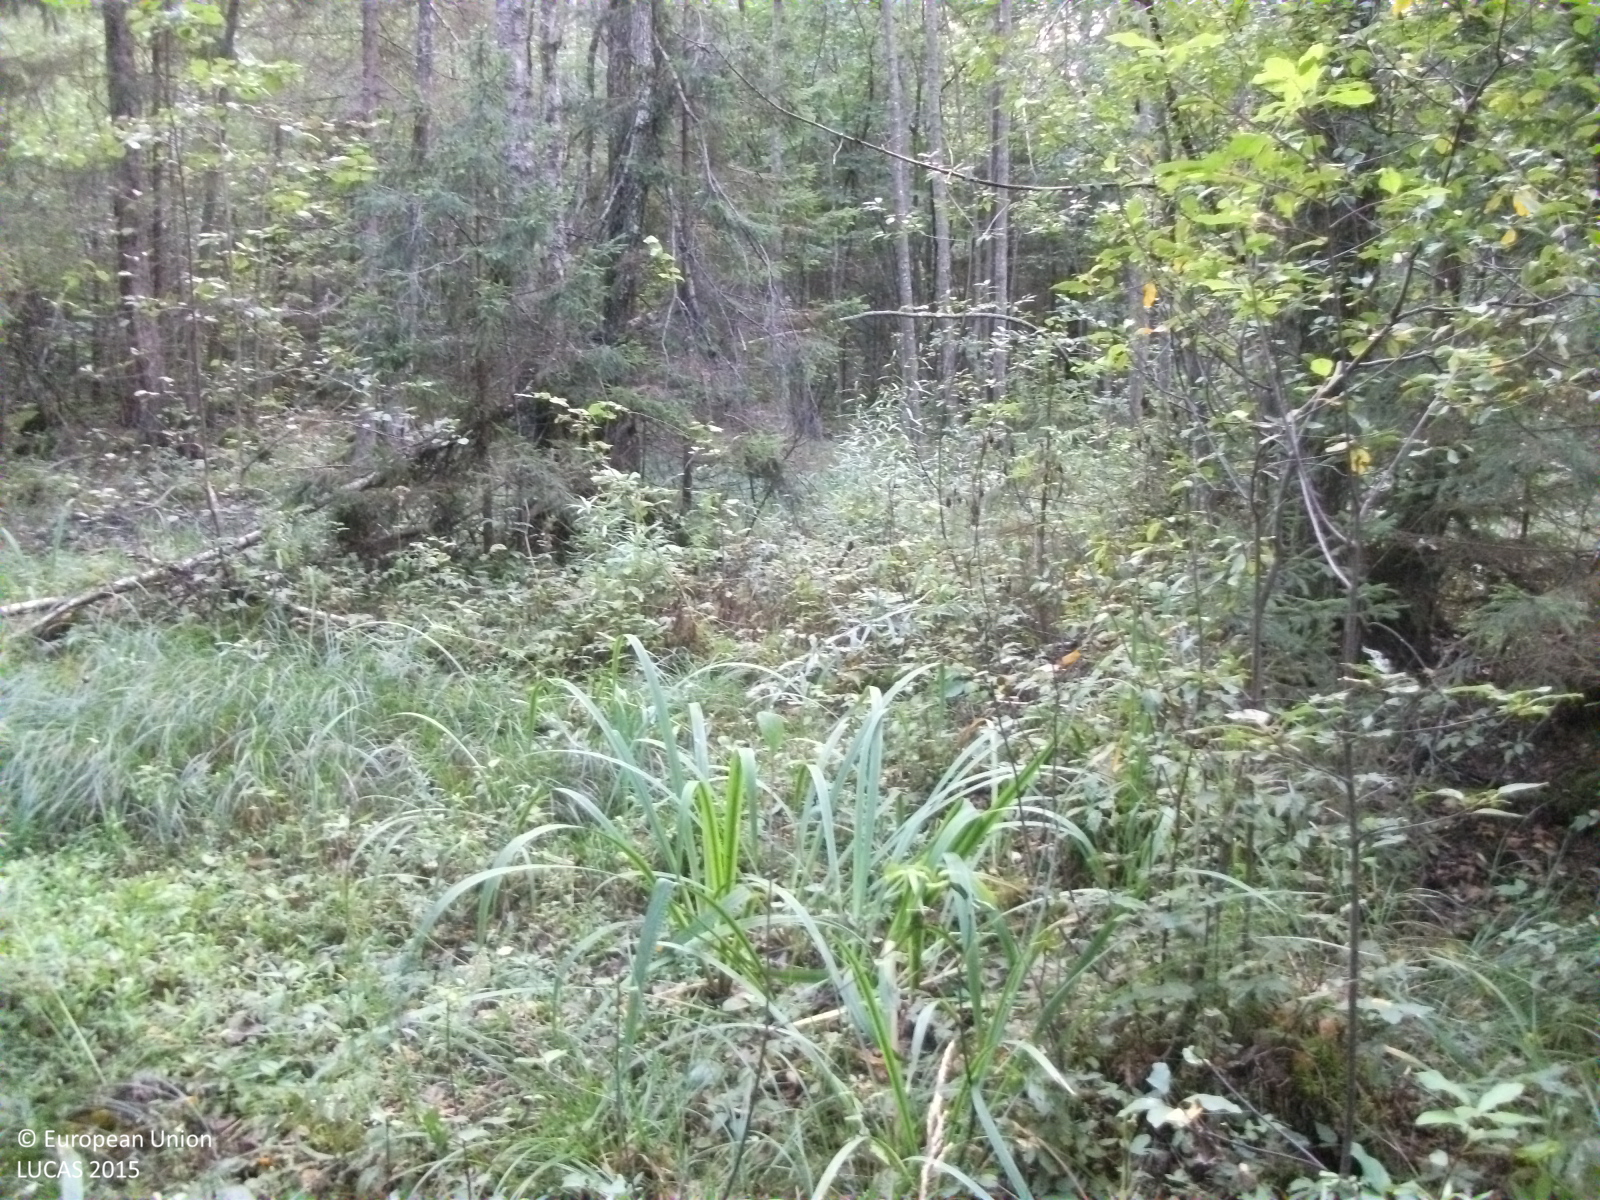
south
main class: Woodland
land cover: Other mixed woodland
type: hemiboreal forest and nemoral coniferous forest and mixed broadleaved-coniferous forest
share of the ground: 50 - 75 %
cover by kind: broadleaved forest trees 50 %, coniferous forest trees 20 %, herbaceous plants 20 %, shrubs 5 %, lichens and mosses 5 %
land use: Forestry
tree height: > 5 m
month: September
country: LV
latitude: 57.5683
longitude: 24.3824
